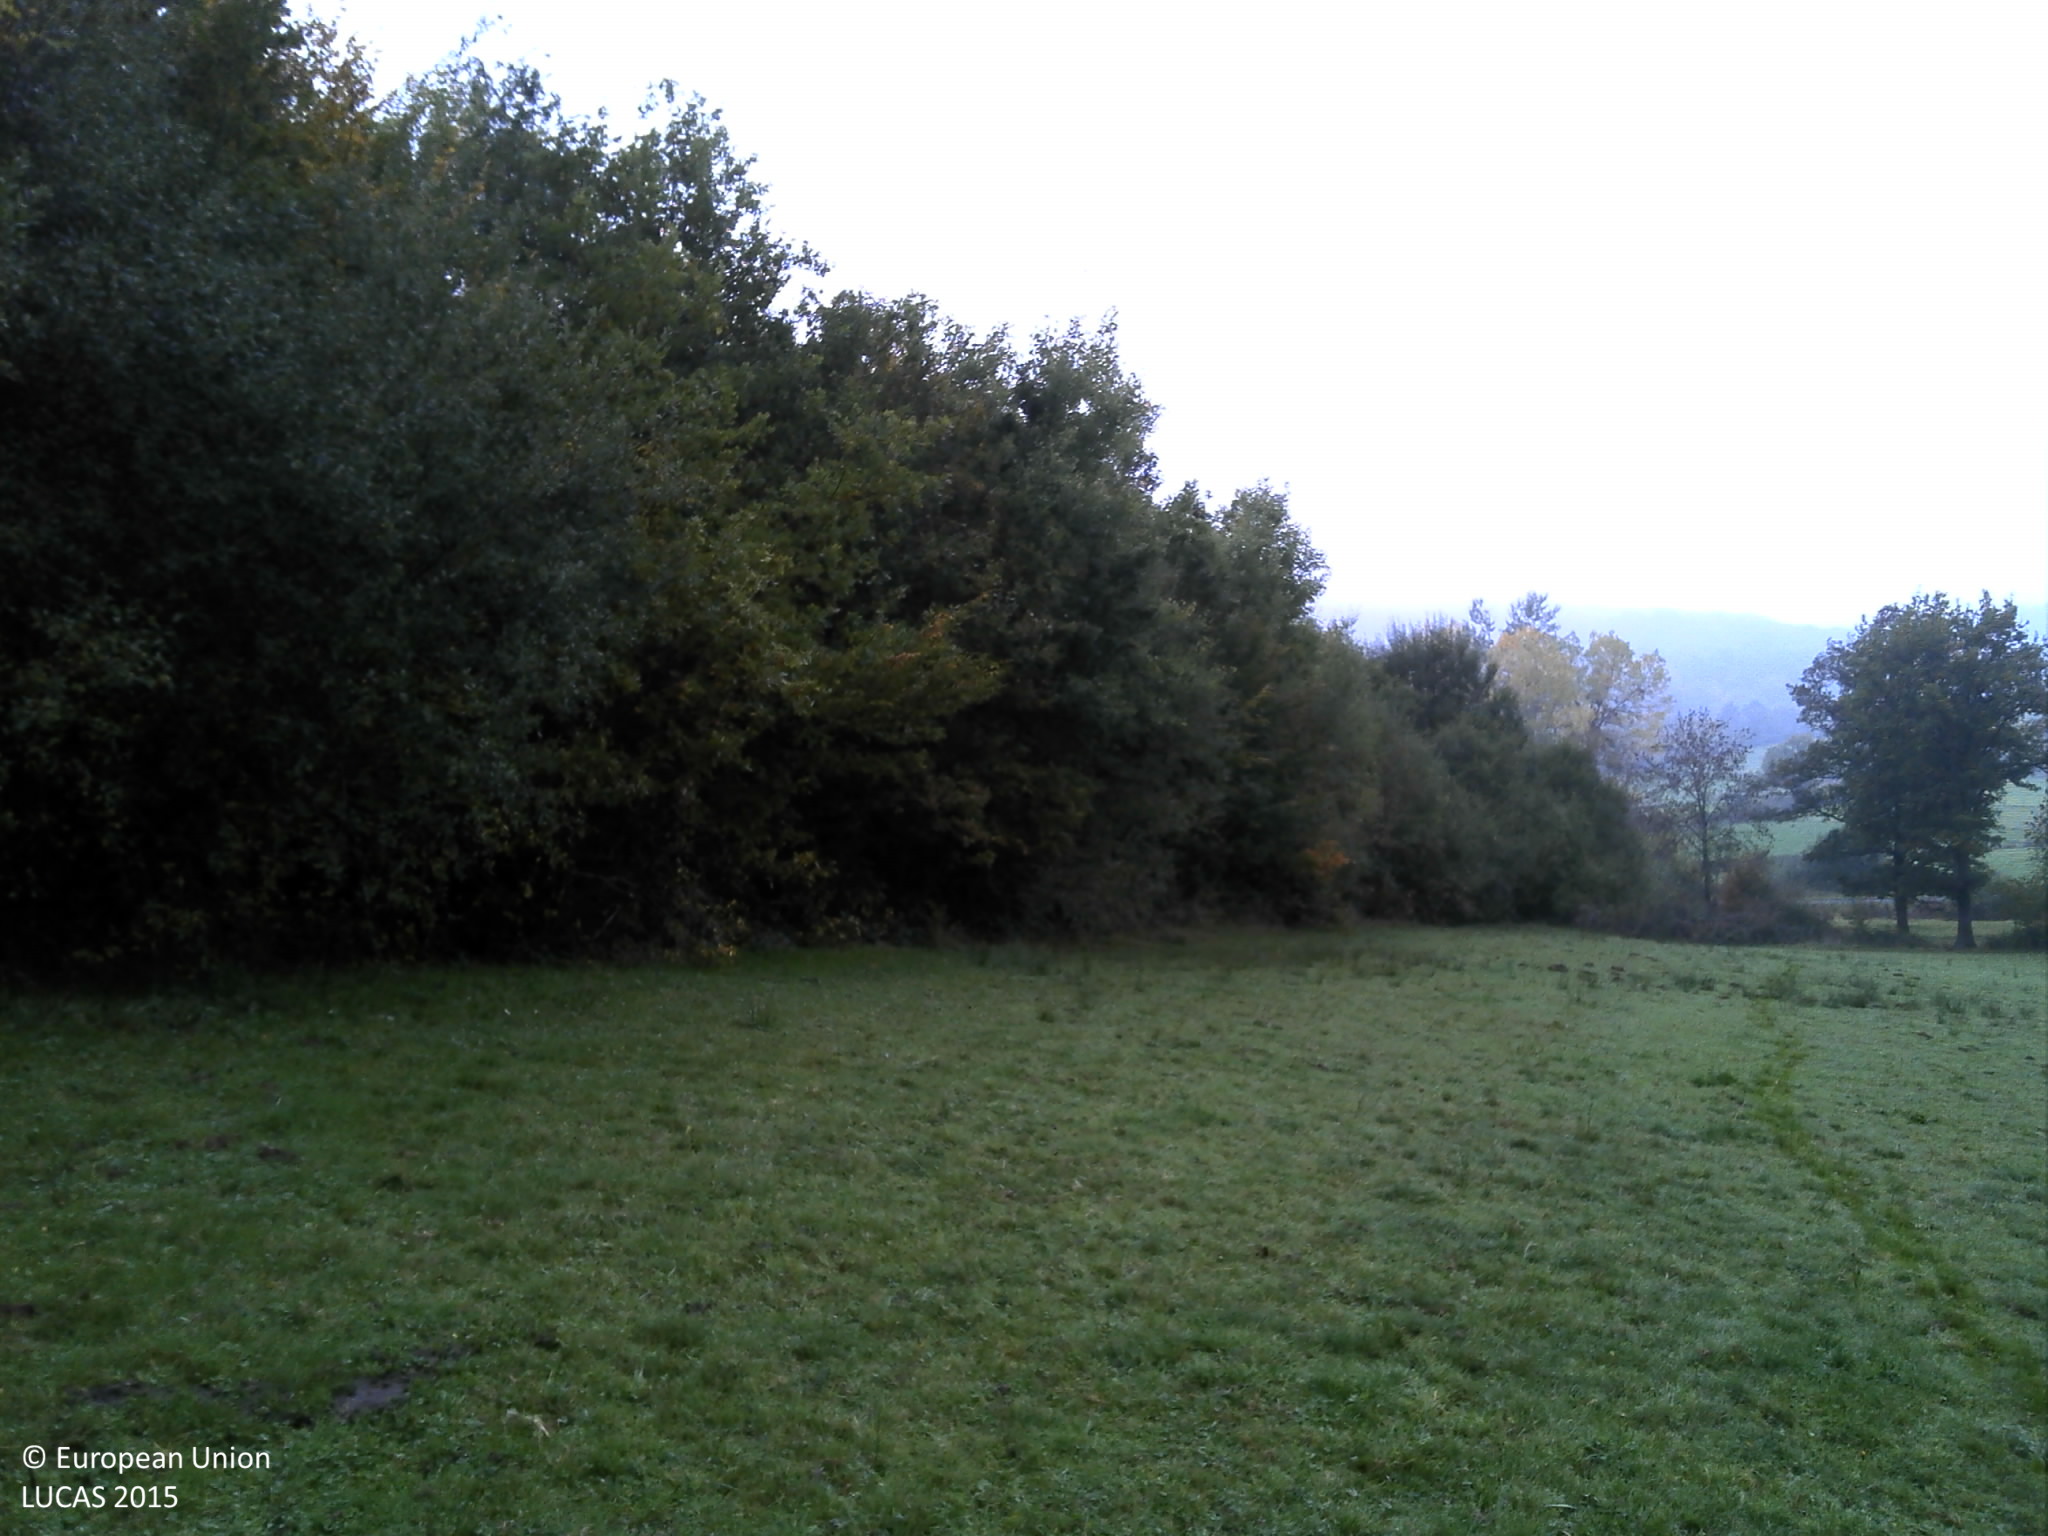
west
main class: Grassland
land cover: Grassland without tree/shrub cover
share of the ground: > 75 %
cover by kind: herbaceous plants 100 %
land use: Agriculture (excluding fallow land and kitchen gardens)
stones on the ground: < 10 %
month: October
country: FR
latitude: 45.6425
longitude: 3.4193
